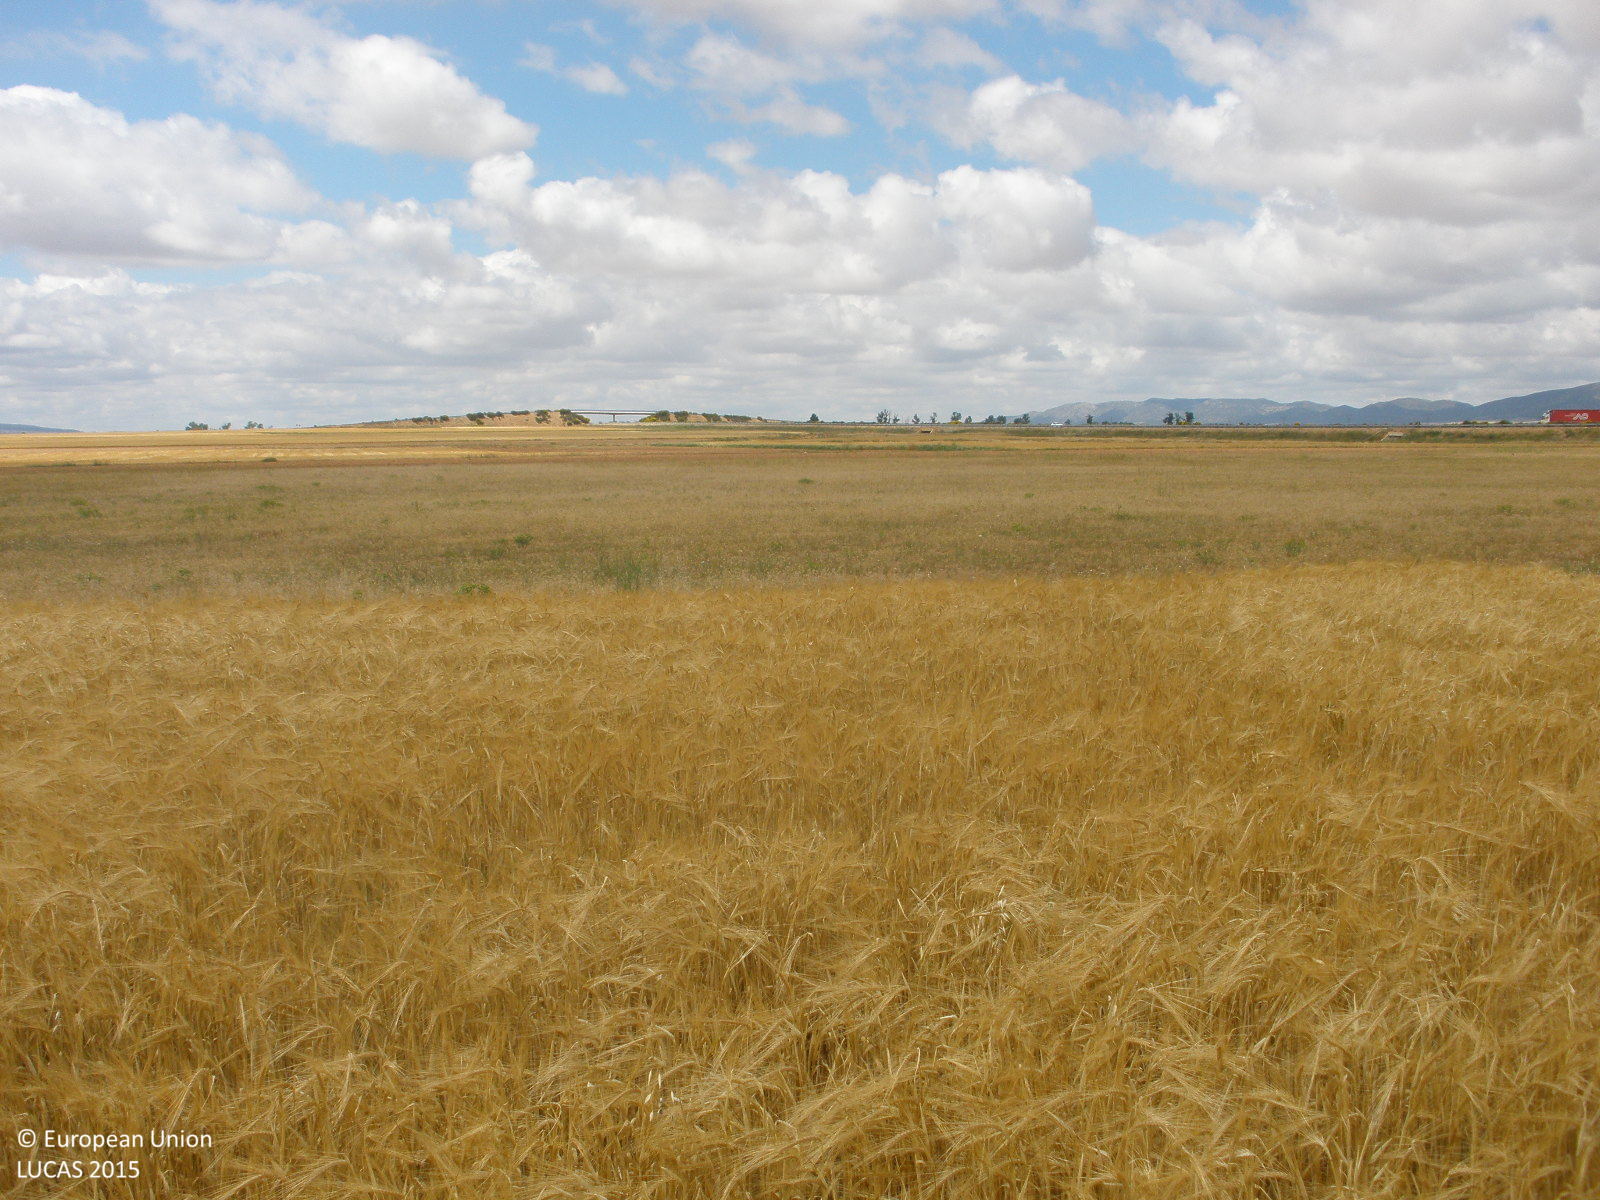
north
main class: Cropland
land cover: Barley
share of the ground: > 75 %
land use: Agriculture (excluding fallow land and kitchen gardens)
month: June
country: ES
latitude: 40.5289
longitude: -1.2637
